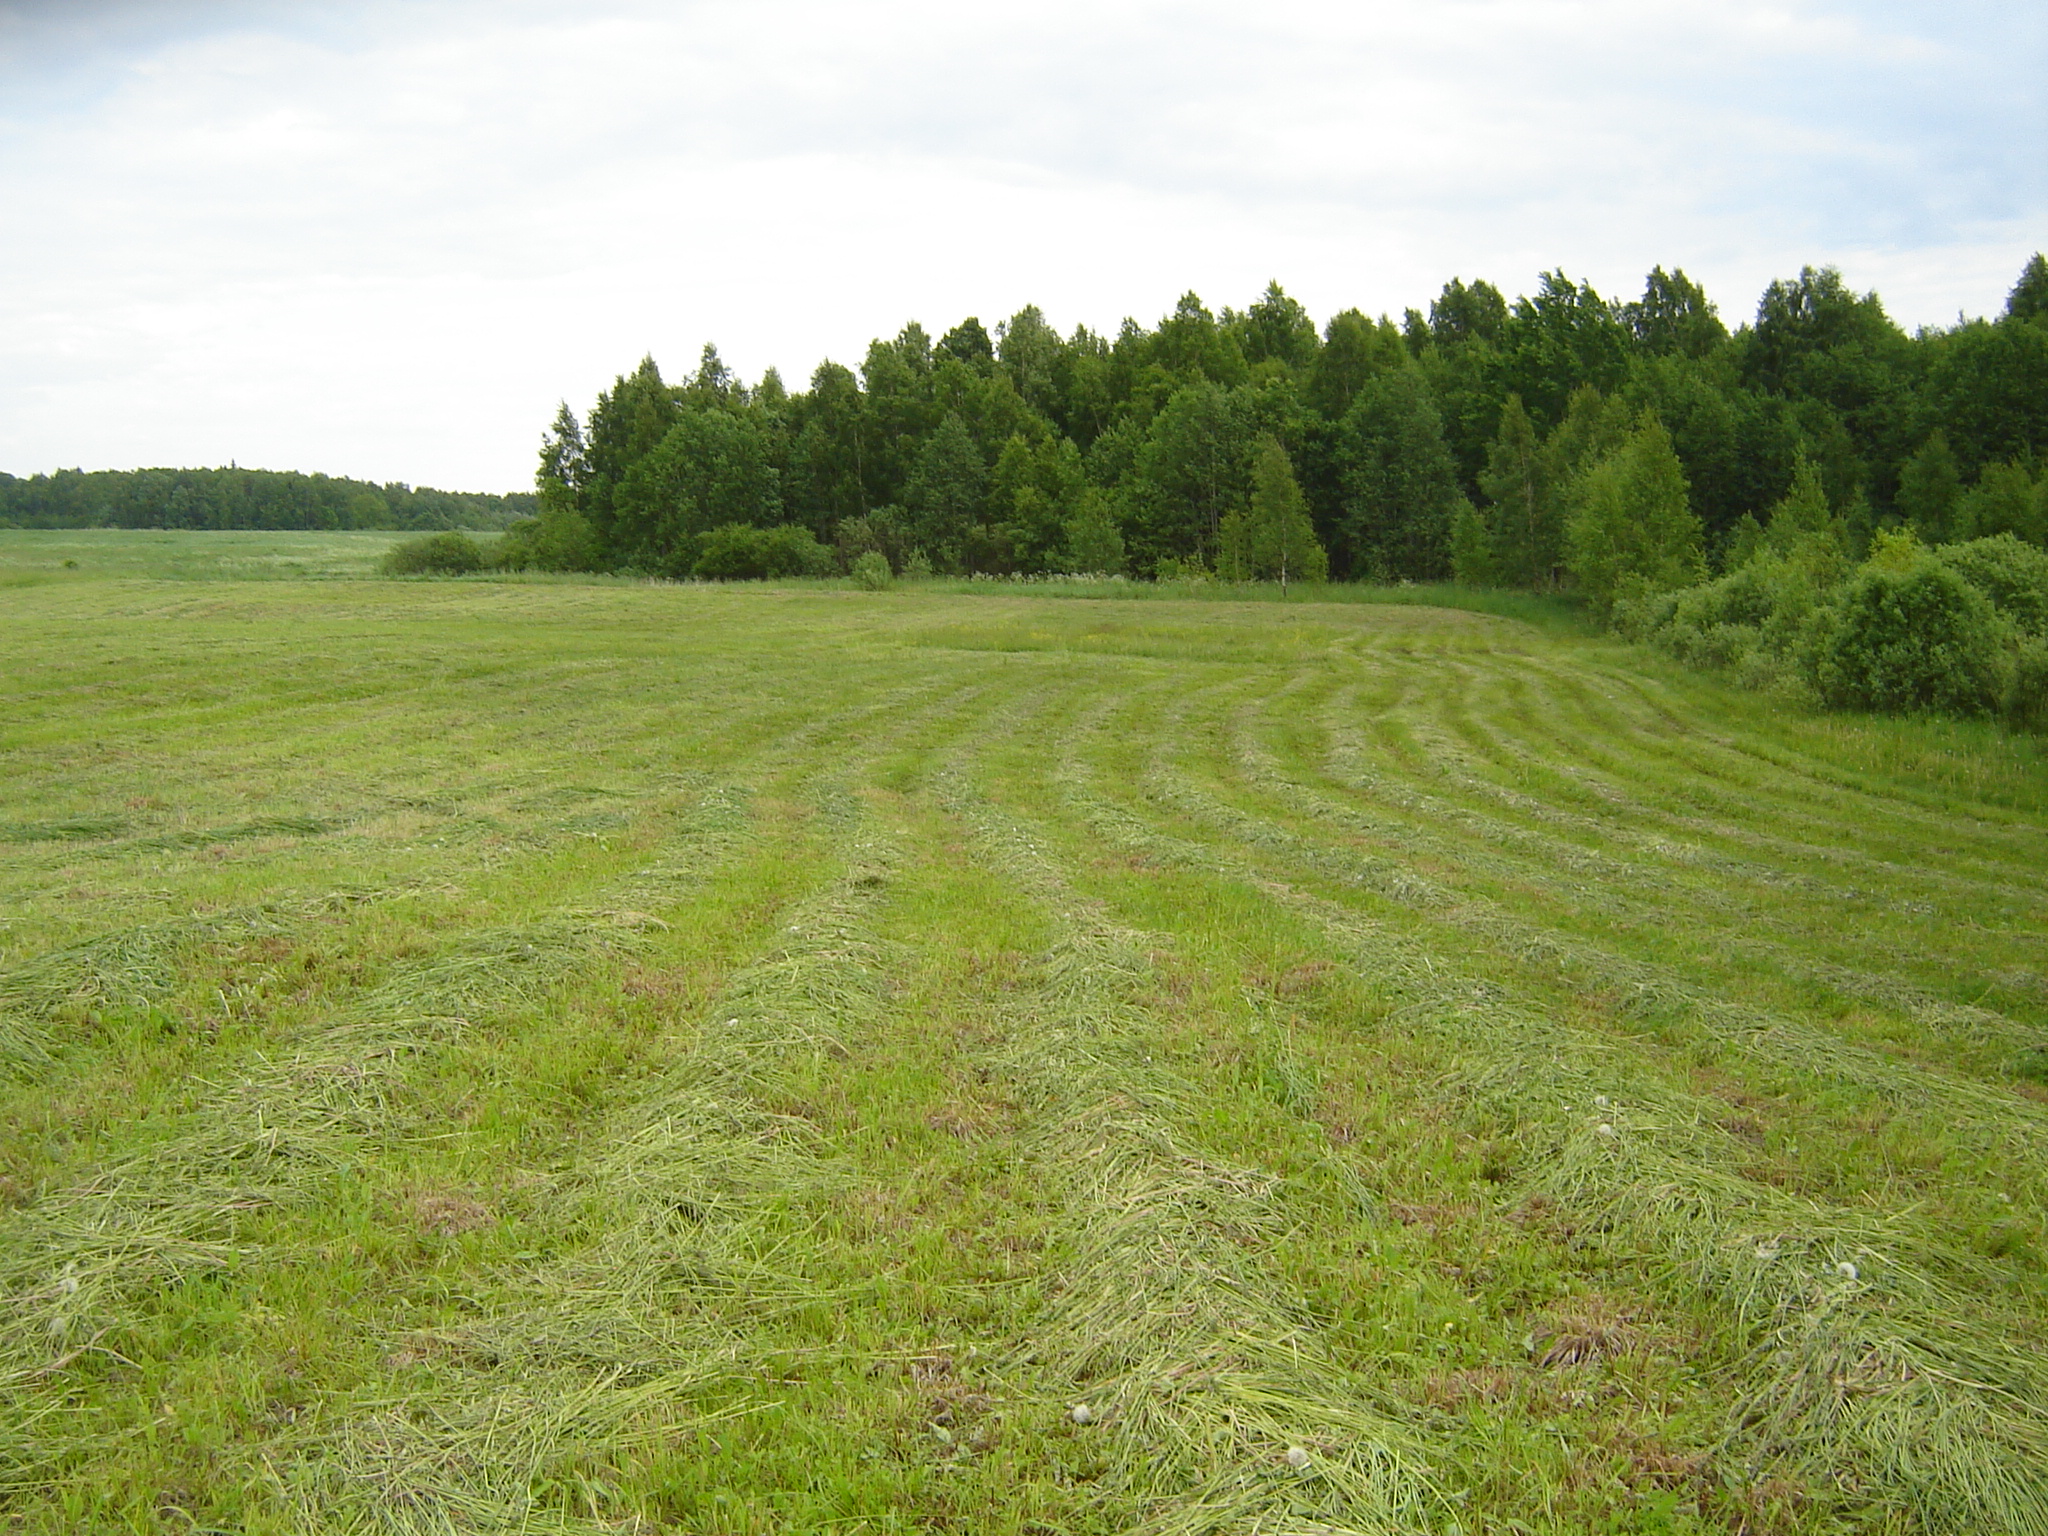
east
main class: Grassland
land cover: Grassland without tree/shrub cover
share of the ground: > 75 %
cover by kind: herbaceous plants 100 %
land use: Agriculture (excluding fallow land and kitchen gardens)
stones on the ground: < 10 %
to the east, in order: Grassland without tree/shrub cover; Broadleaved woodland; Spontaneously vegetated surfaces; Ditches and canals; Spontaneously vegetated surfaces
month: June
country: LT
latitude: 55.7923
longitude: 25.6129
